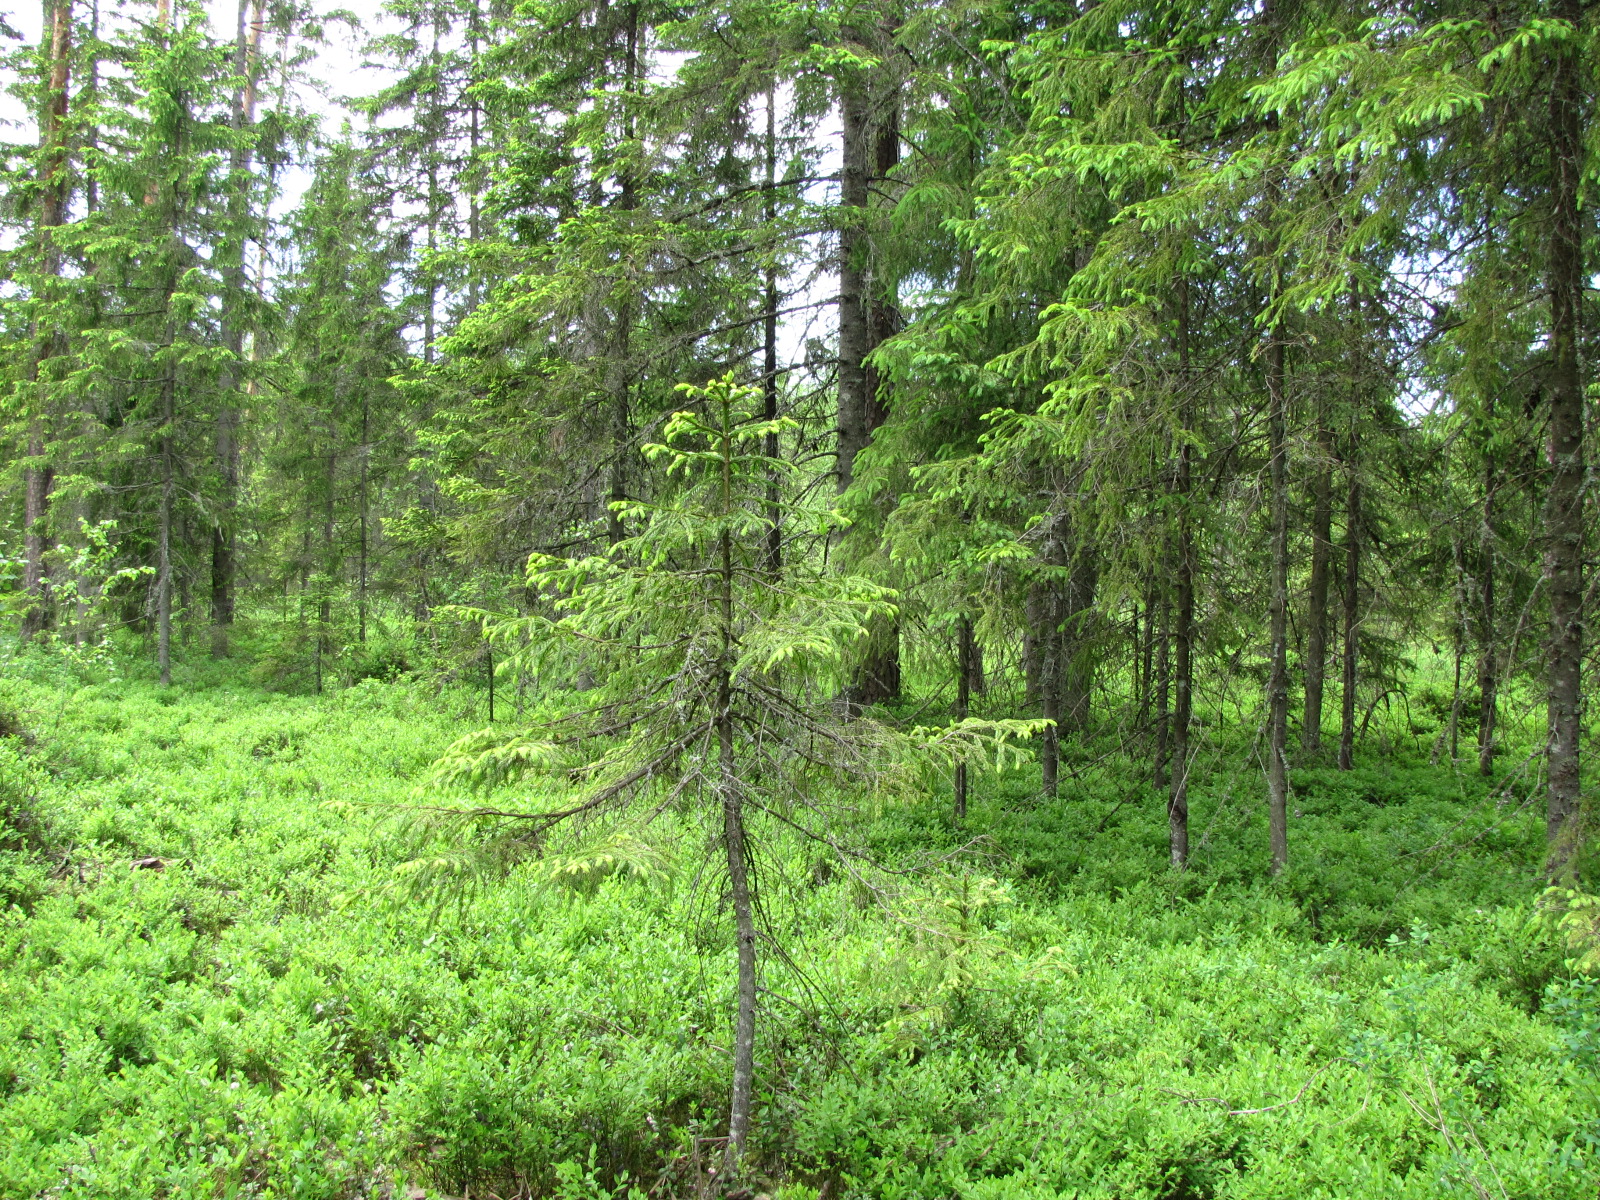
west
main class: Woodland
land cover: Other coniferous woodland
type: hemiboreal forest and nemoral coniferous forest and mixed broadleaved-coniferous forest
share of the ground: 50 - 75 %
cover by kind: coniferous forest trees 50 %, herbaceous plants 40 %, lichens and mosses 10 %
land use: Forestry
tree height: > 5 m
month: June
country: LV
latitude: 56.9530
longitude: 24.4801
